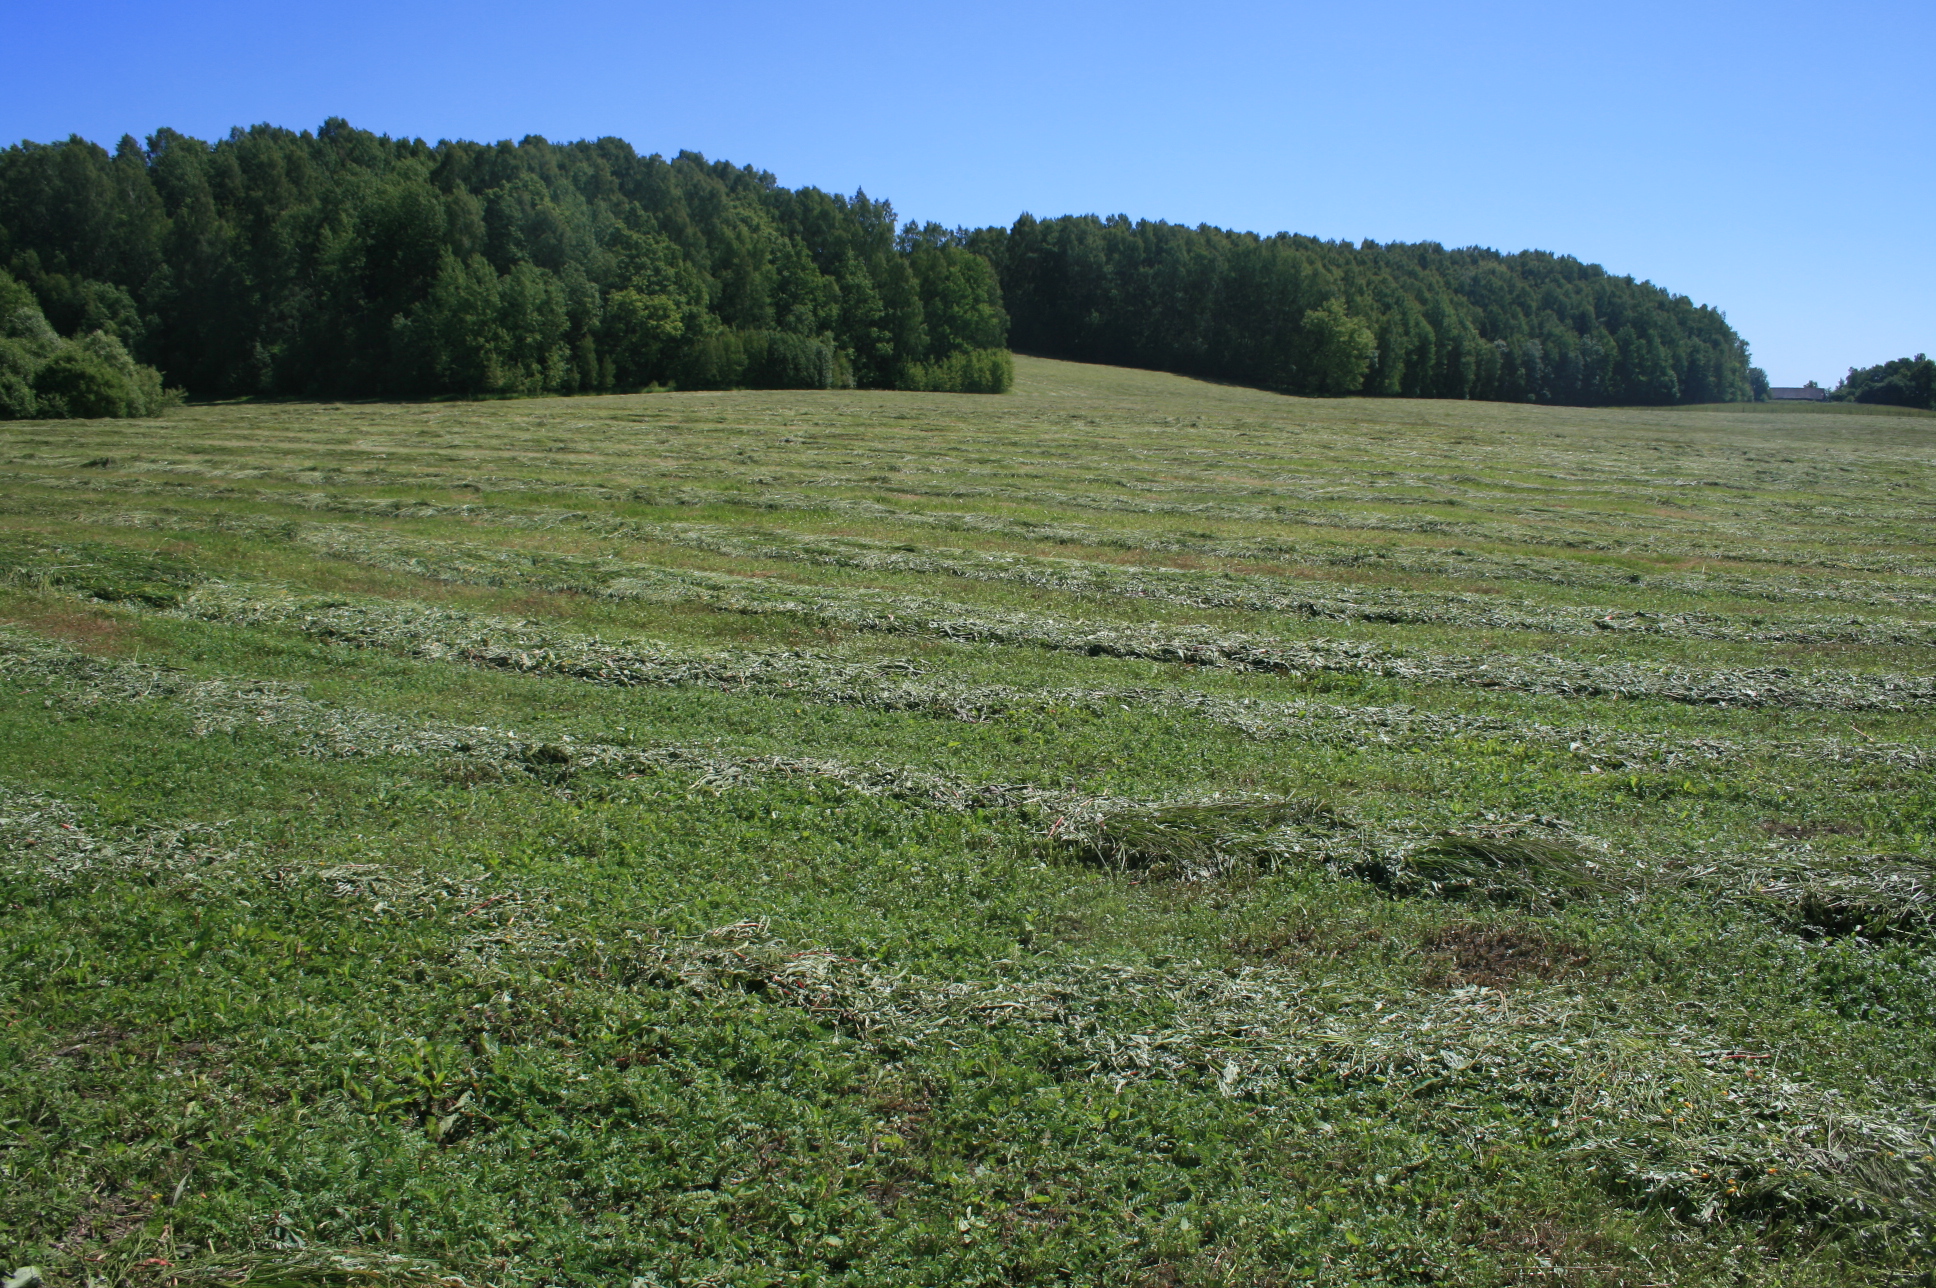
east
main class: Grassland
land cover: Grassland without tree/shrub cover
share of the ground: > 75 %
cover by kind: herbaceous plants 100 %
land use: Agriculture (excluding fallow land and kitchen gardens)
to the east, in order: Grassland without tree/shrub cover; Broadleaved woodland
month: June
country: LT
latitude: 55.5769
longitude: 22.0932
